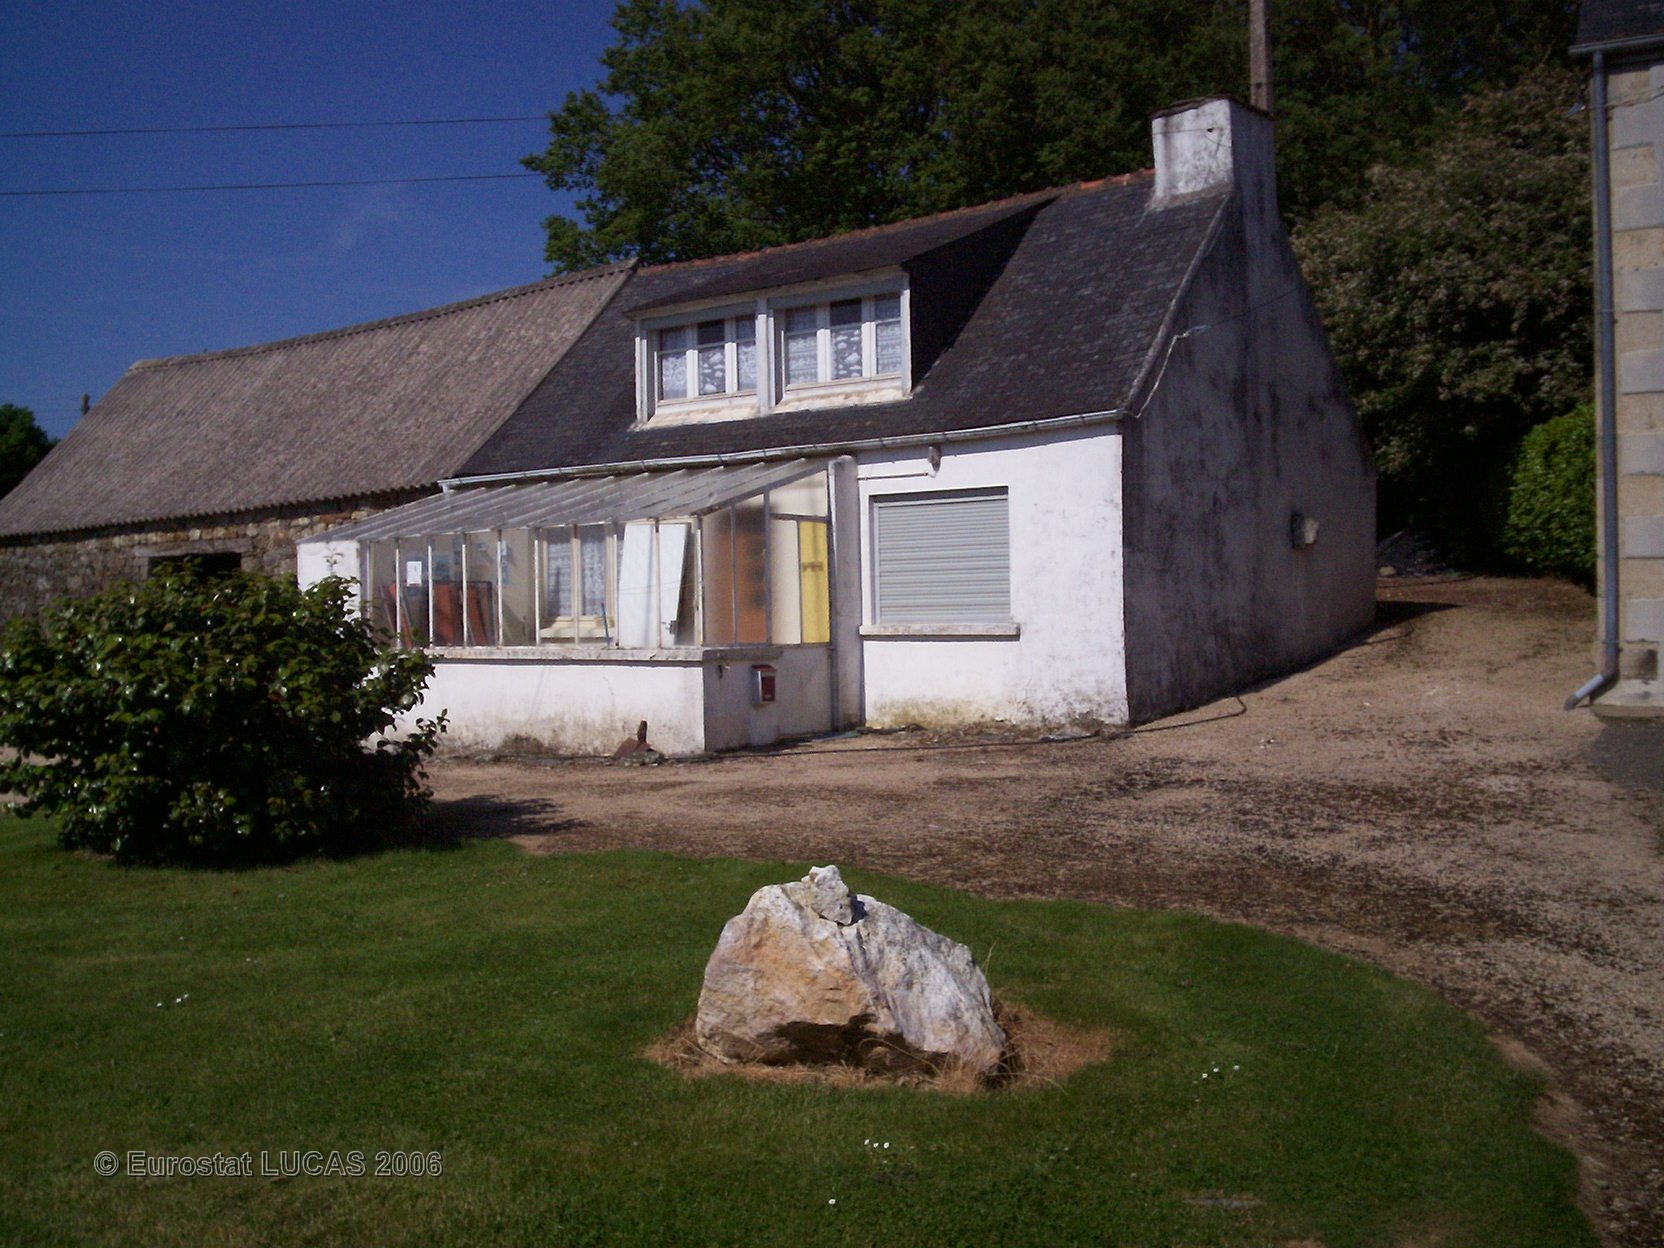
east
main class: Grassland
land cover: Grassland with sparse tree/shrub cover
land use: Residential
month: June
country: FR
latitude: 48.4229
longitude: -3.6900
